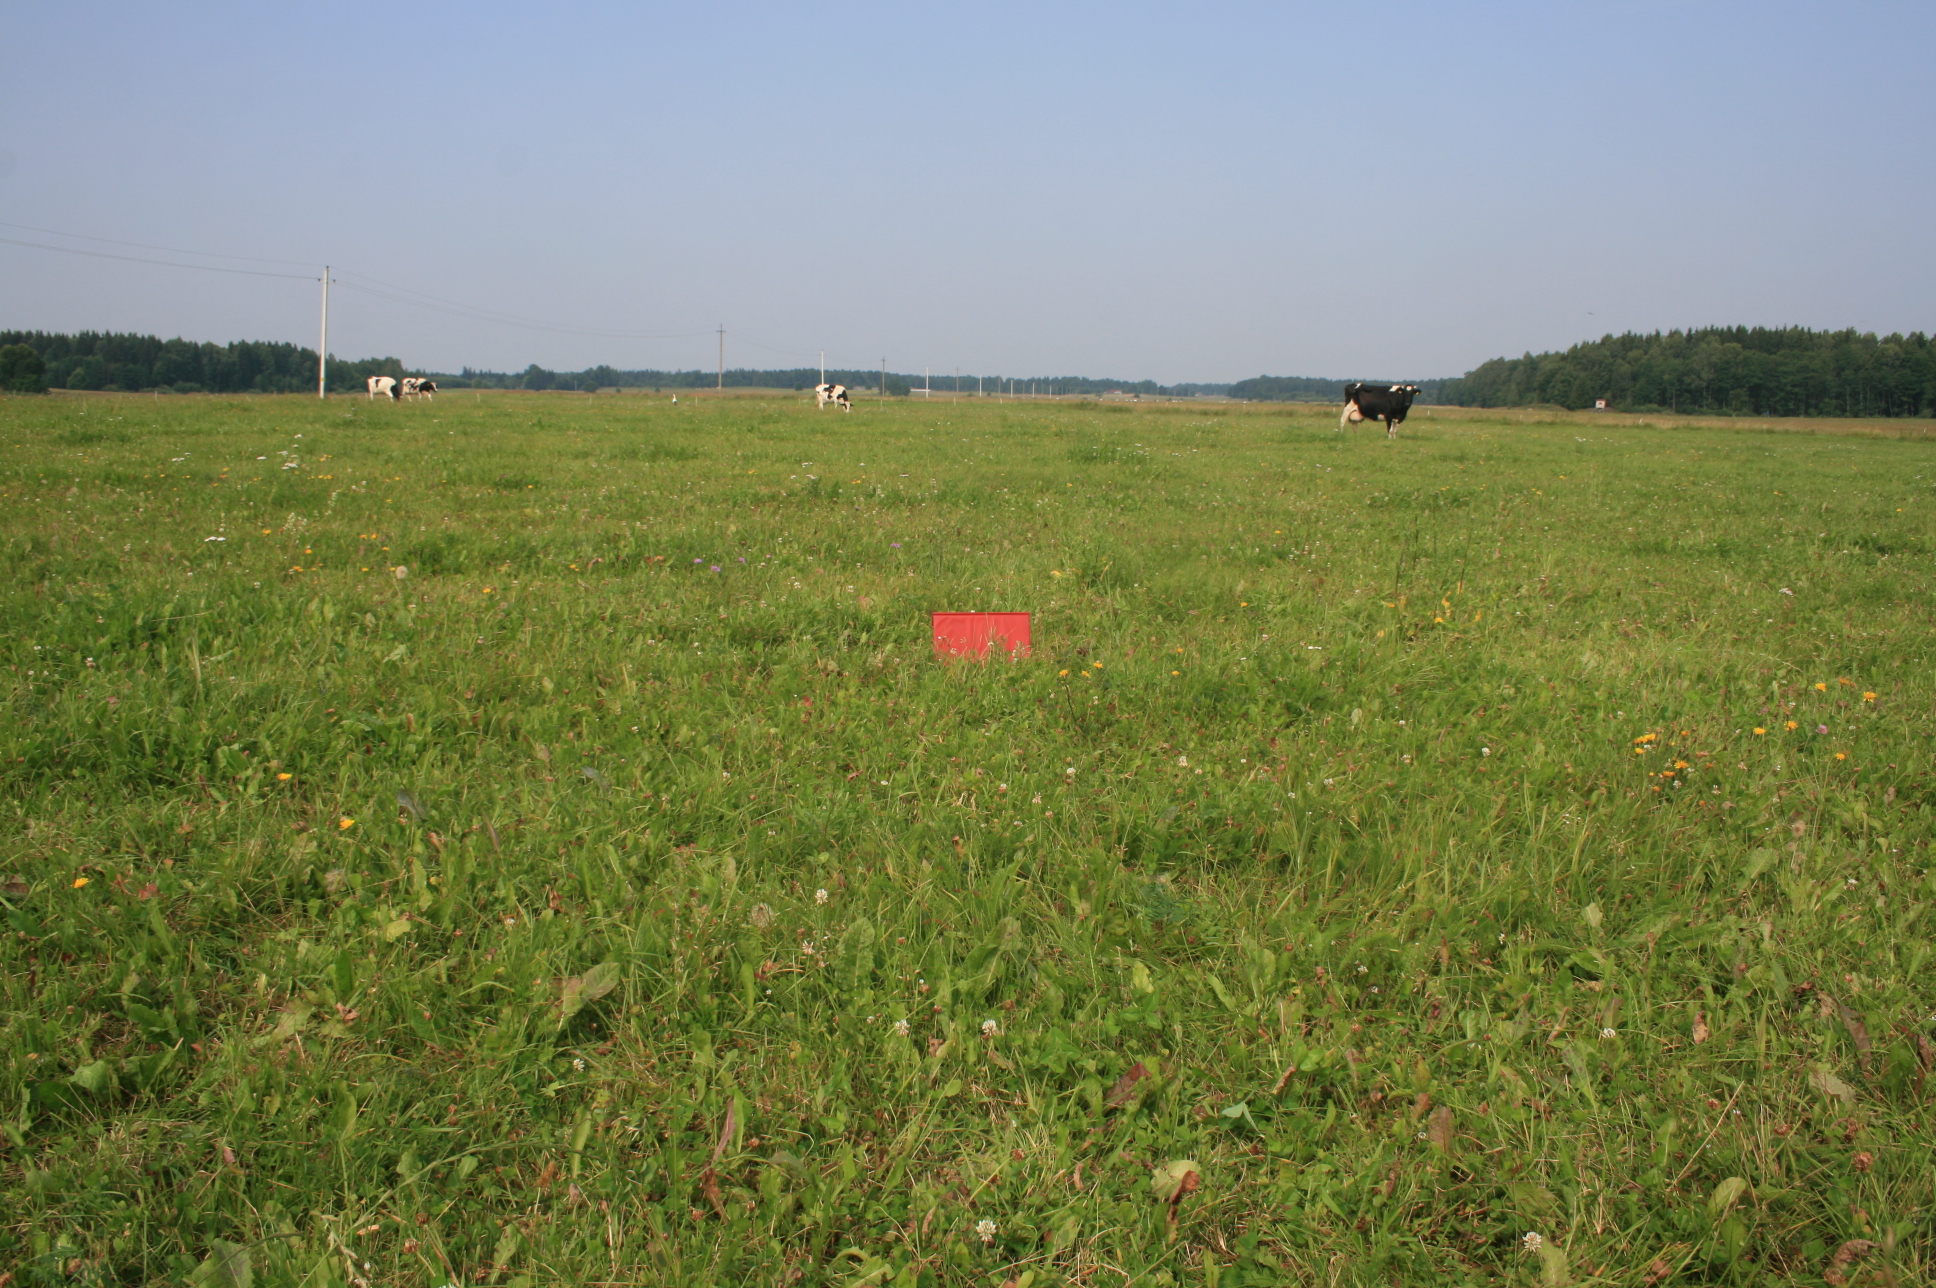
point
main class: Grassland
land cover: Grassland without tree/shrub cover
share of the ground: > 75 %
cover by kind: herbaceous plants 100 %
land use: Agriculture (excluding fallow land and kitchen gardens)
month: August
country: LT
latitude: 55.5800
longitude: 21.8687
